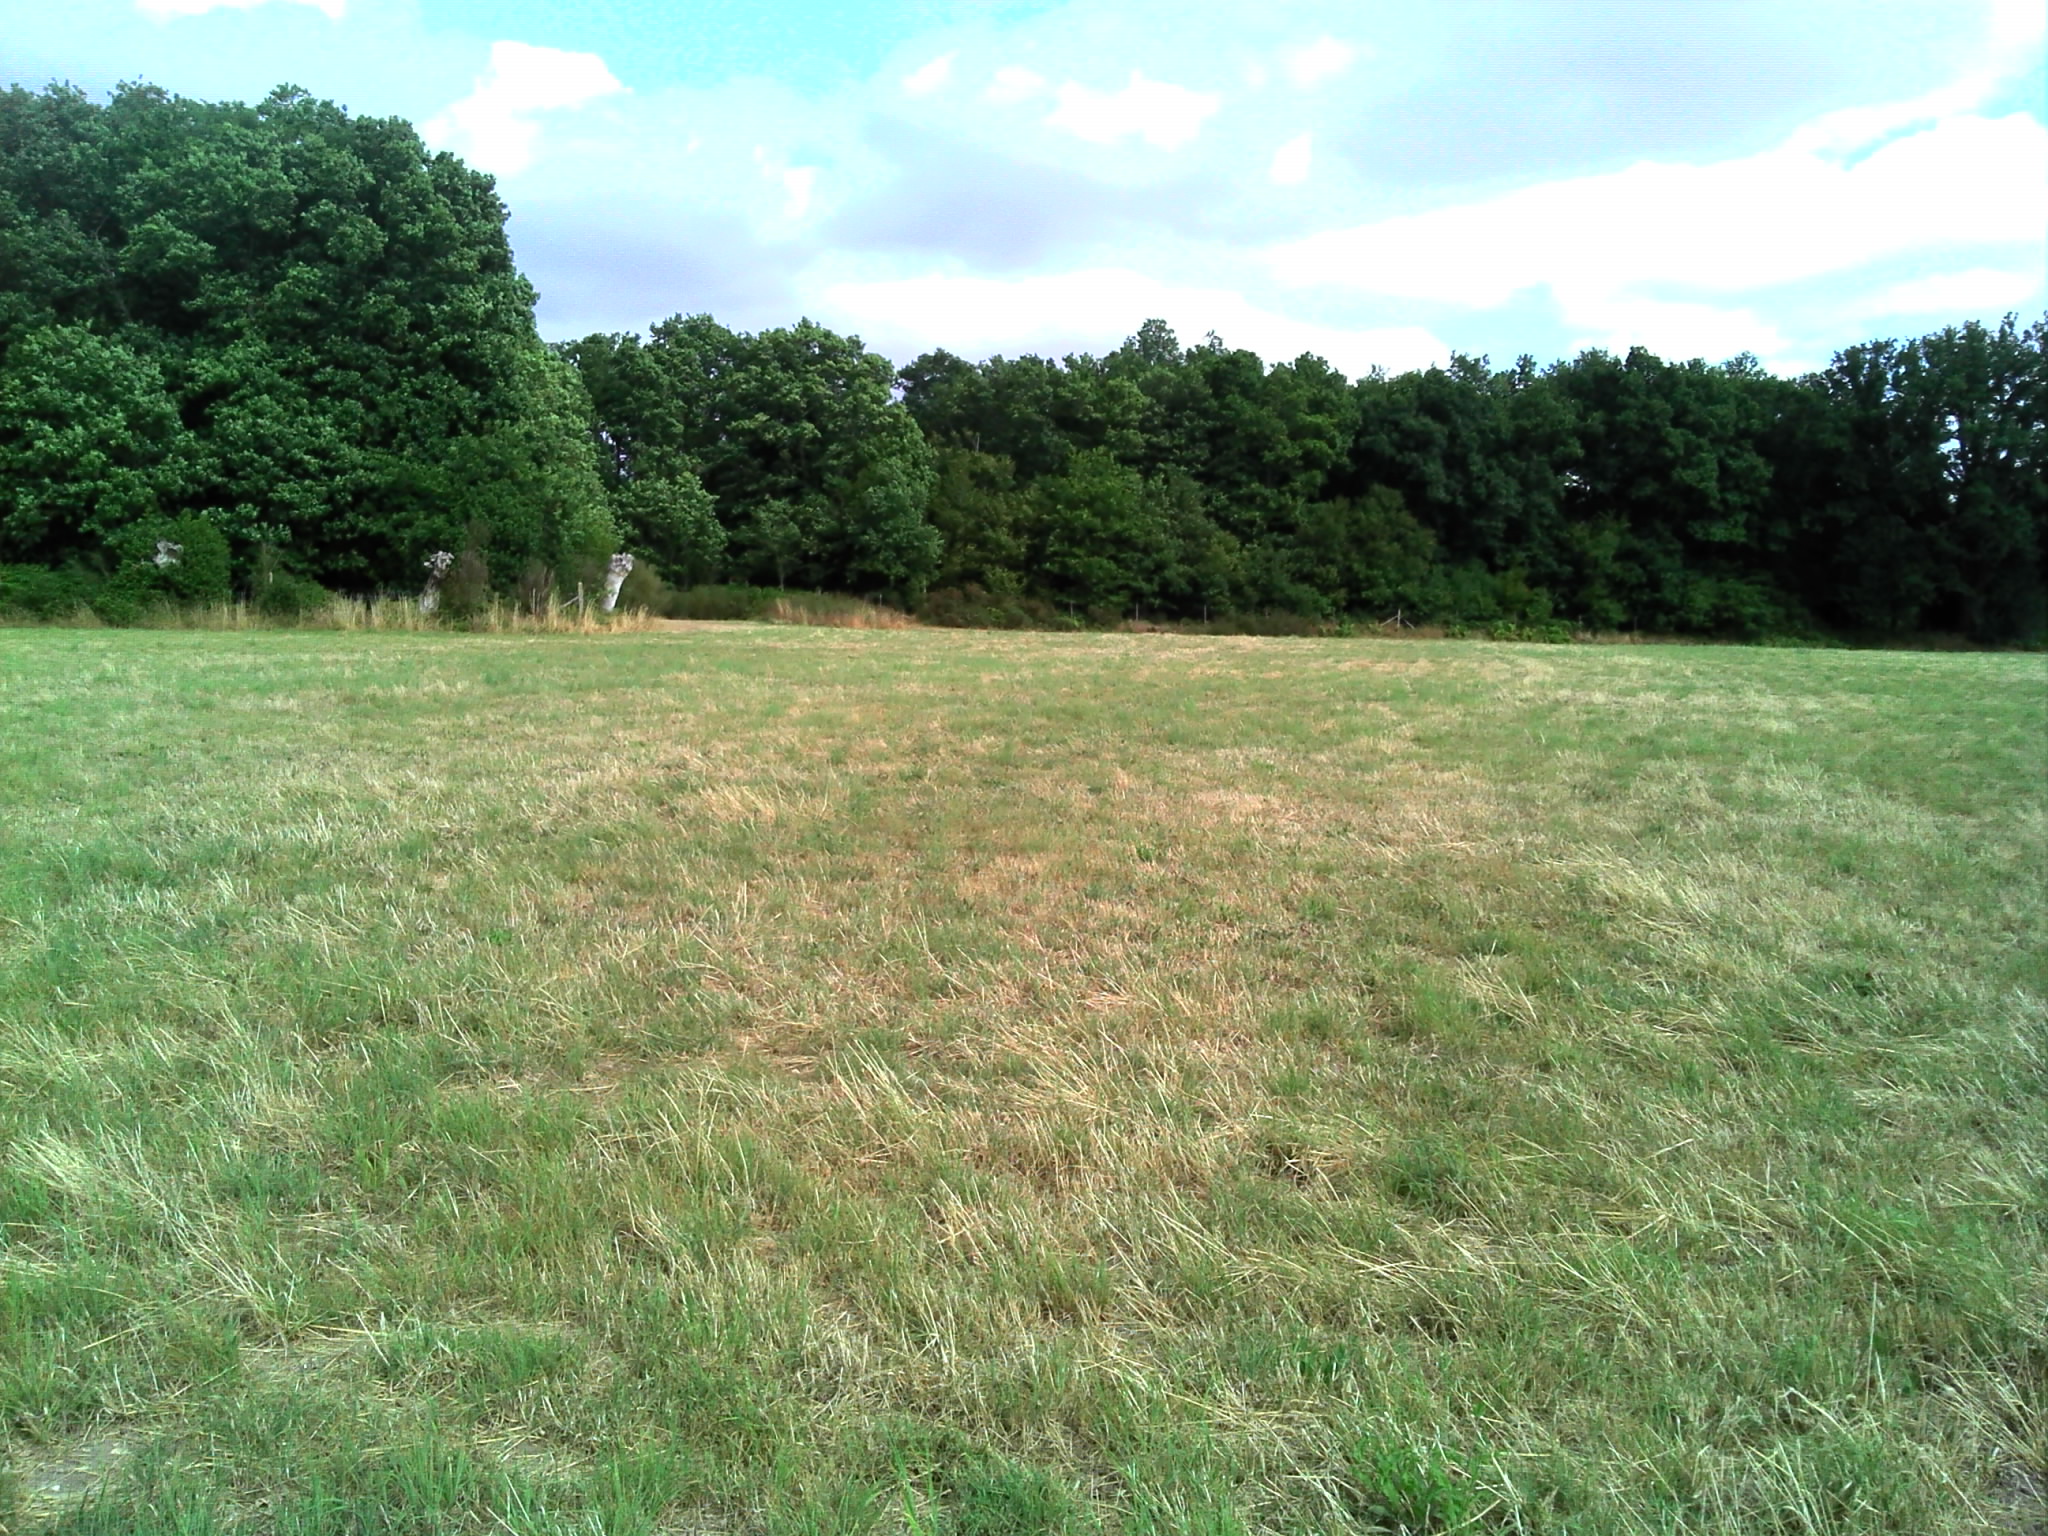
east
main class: Grassland
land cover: Grassland without tree/shrub cover
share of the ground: > 75 %
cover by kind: herbaceous plants 100 %
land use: Agriculture (excluding fallow land and kitchen gardens)
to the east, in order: Grassland without tree/shrub cover; Fences; Broadleaved woodland; Tracks; Shrubland without tree cover
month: July
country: FR
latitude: 48.9325
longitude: 1.1204
